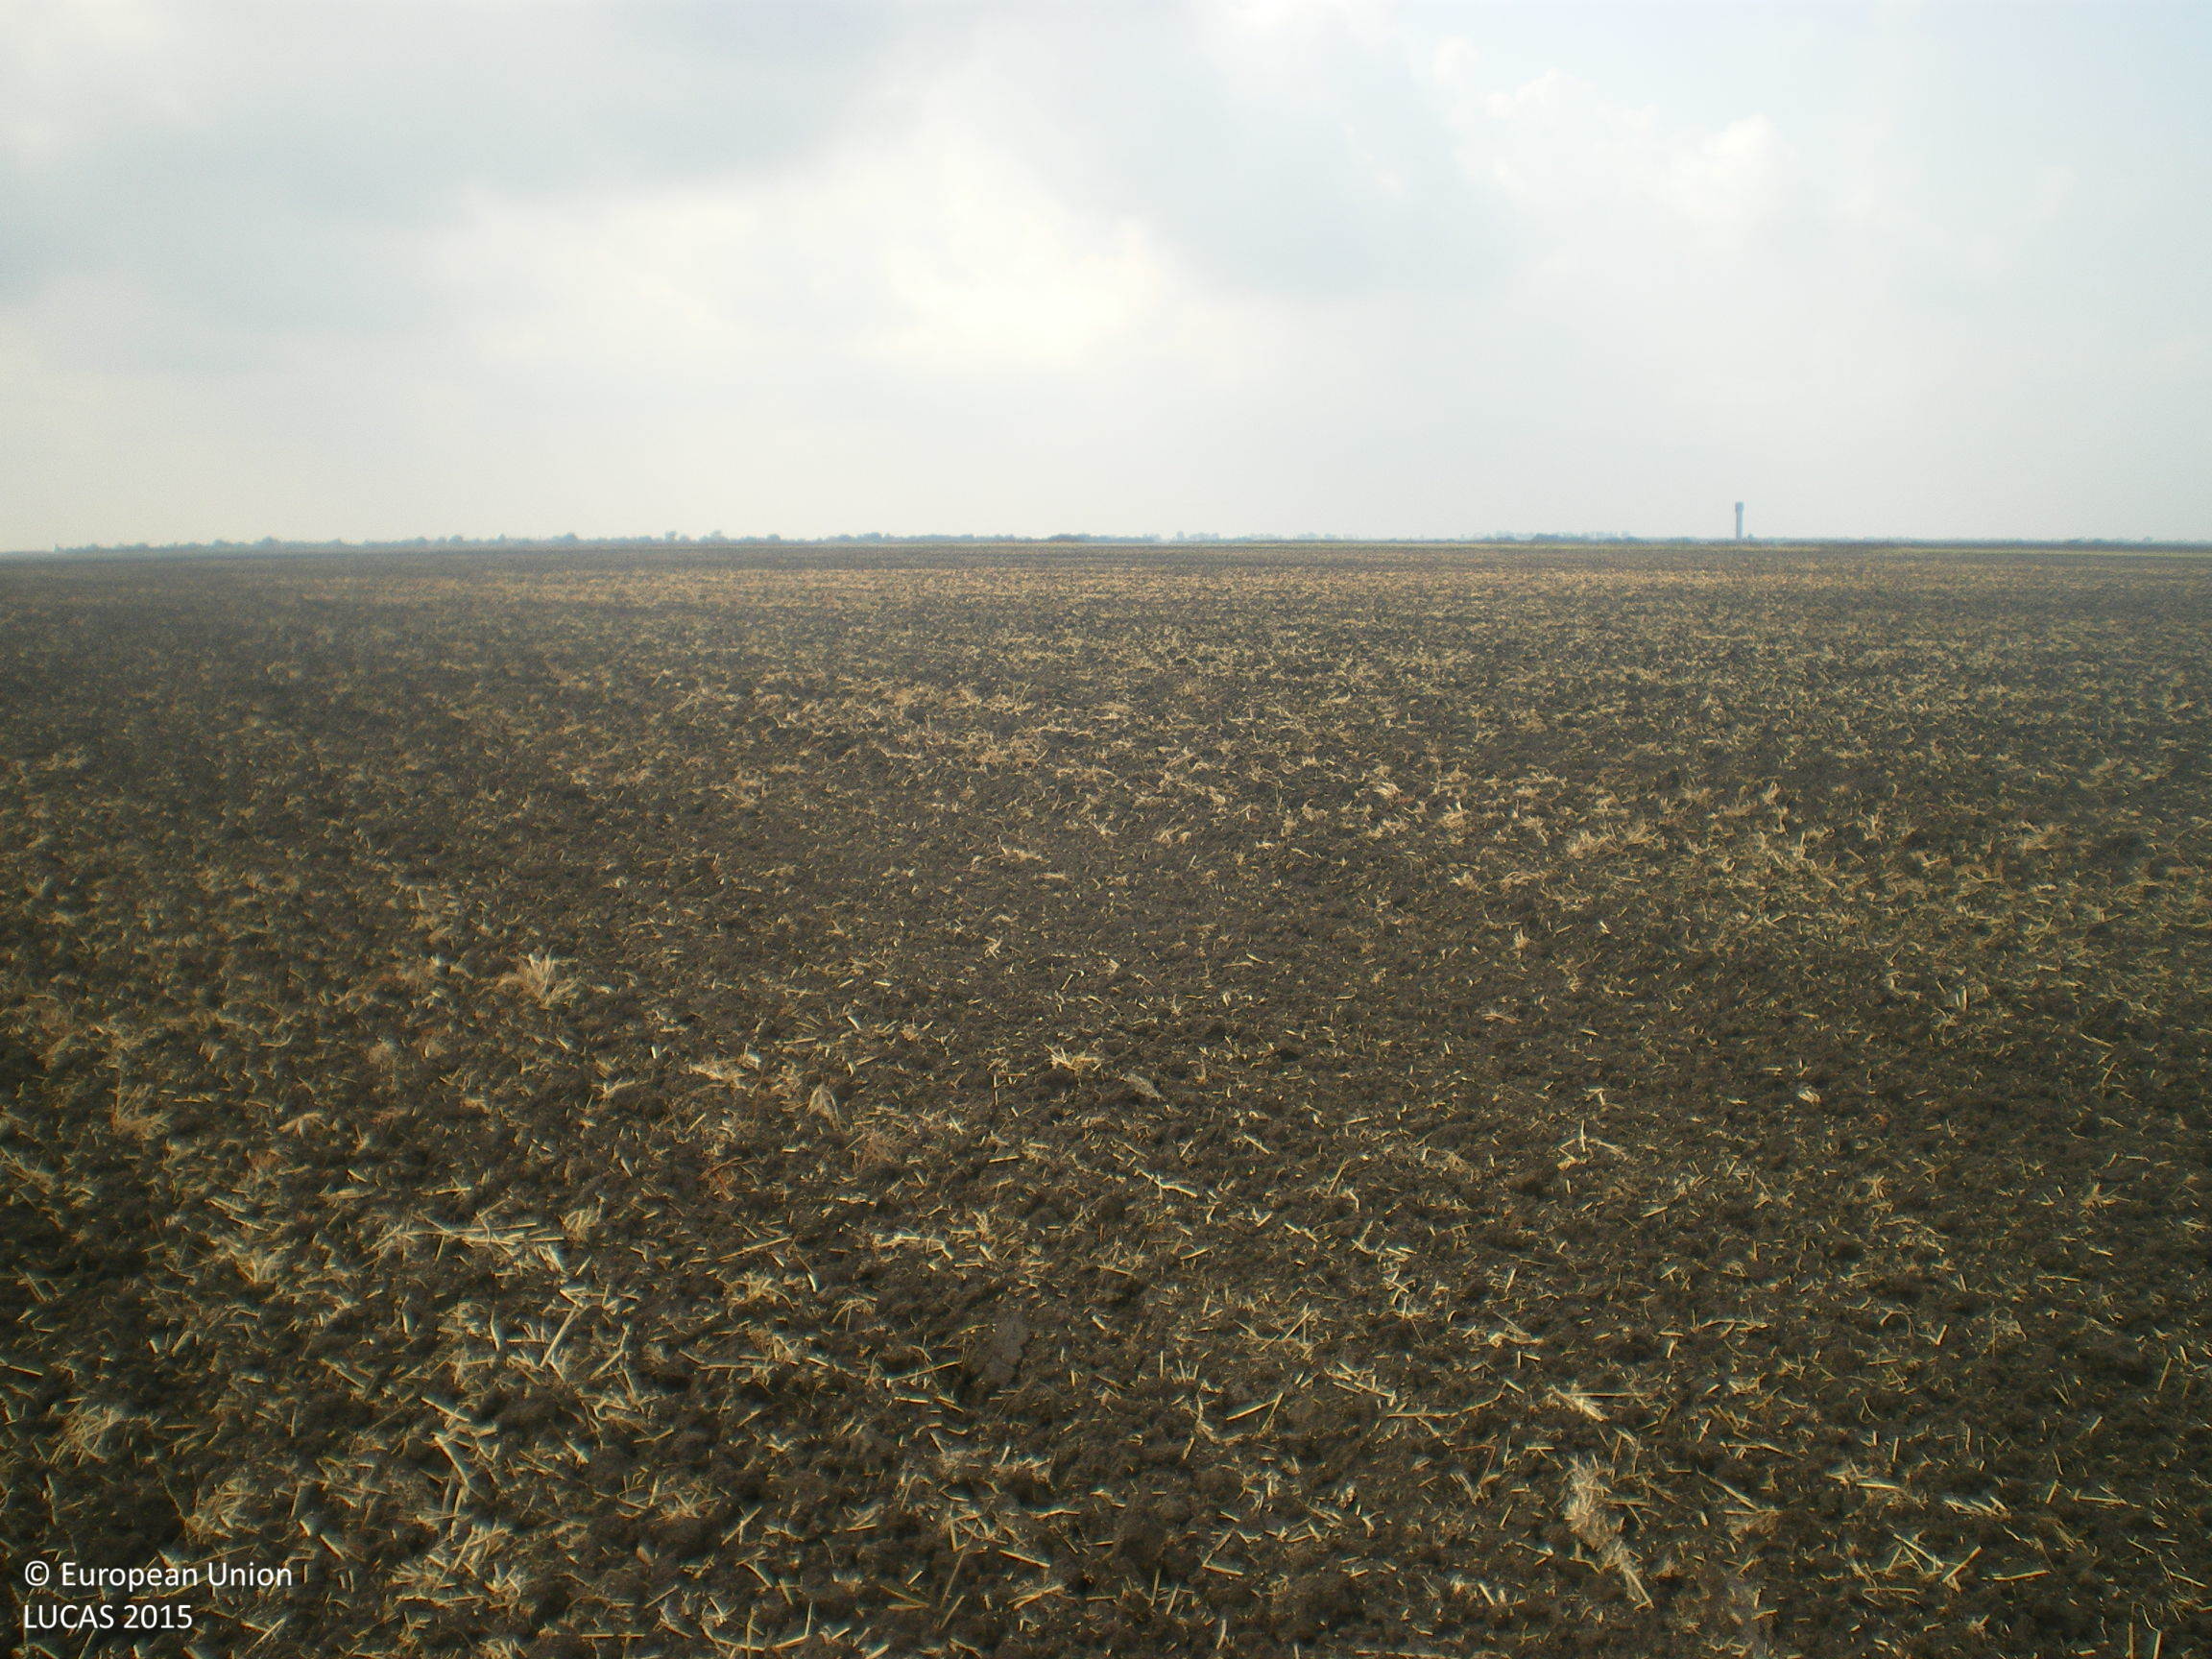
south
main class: Cropland
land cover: Common wheat
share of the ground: < 10 %
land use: Agriculture (excluding fallow land and kitchen gardens)
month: August
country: BG
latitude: 42.3626
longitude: 25.8979
